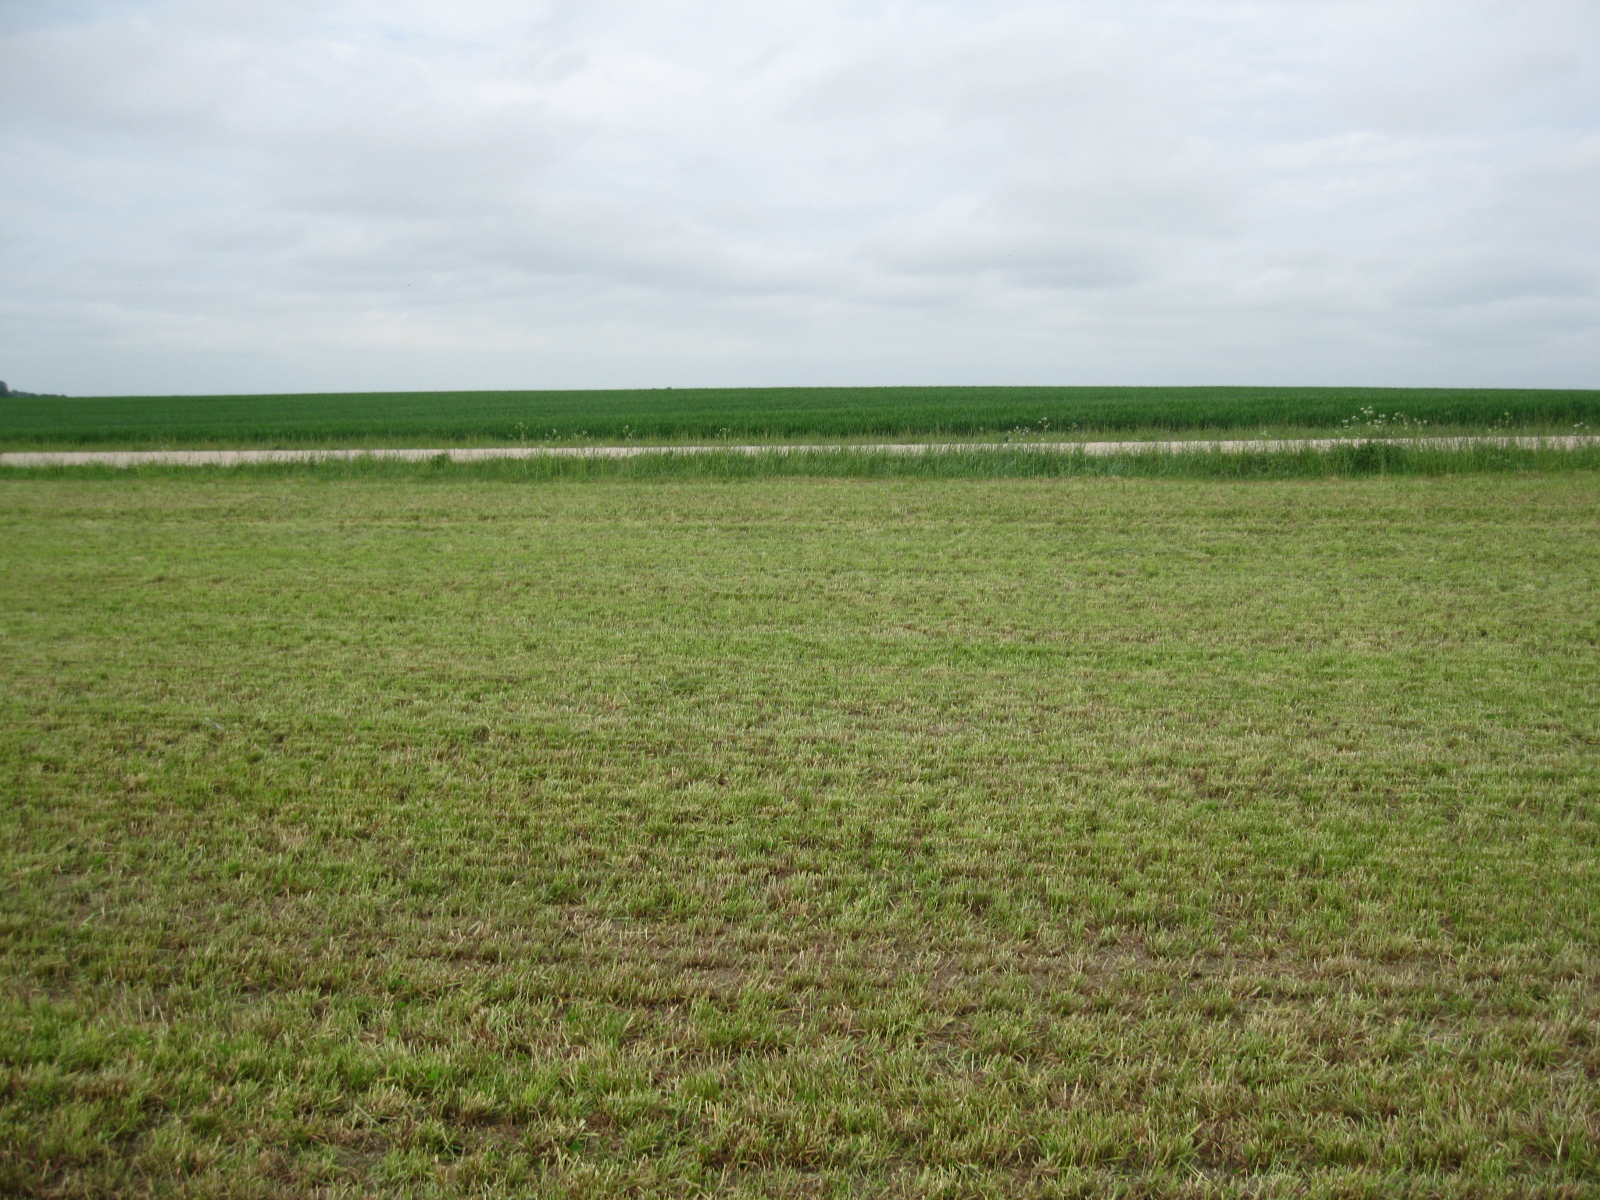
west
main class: Cropland
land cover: Temporary grasslands
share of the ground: > 75 %
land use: Agriculture (excluding fallow land and kitchen gardens)
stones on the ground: < 10 %
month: June
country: LT
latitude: 55.9485
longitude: 24.1341
